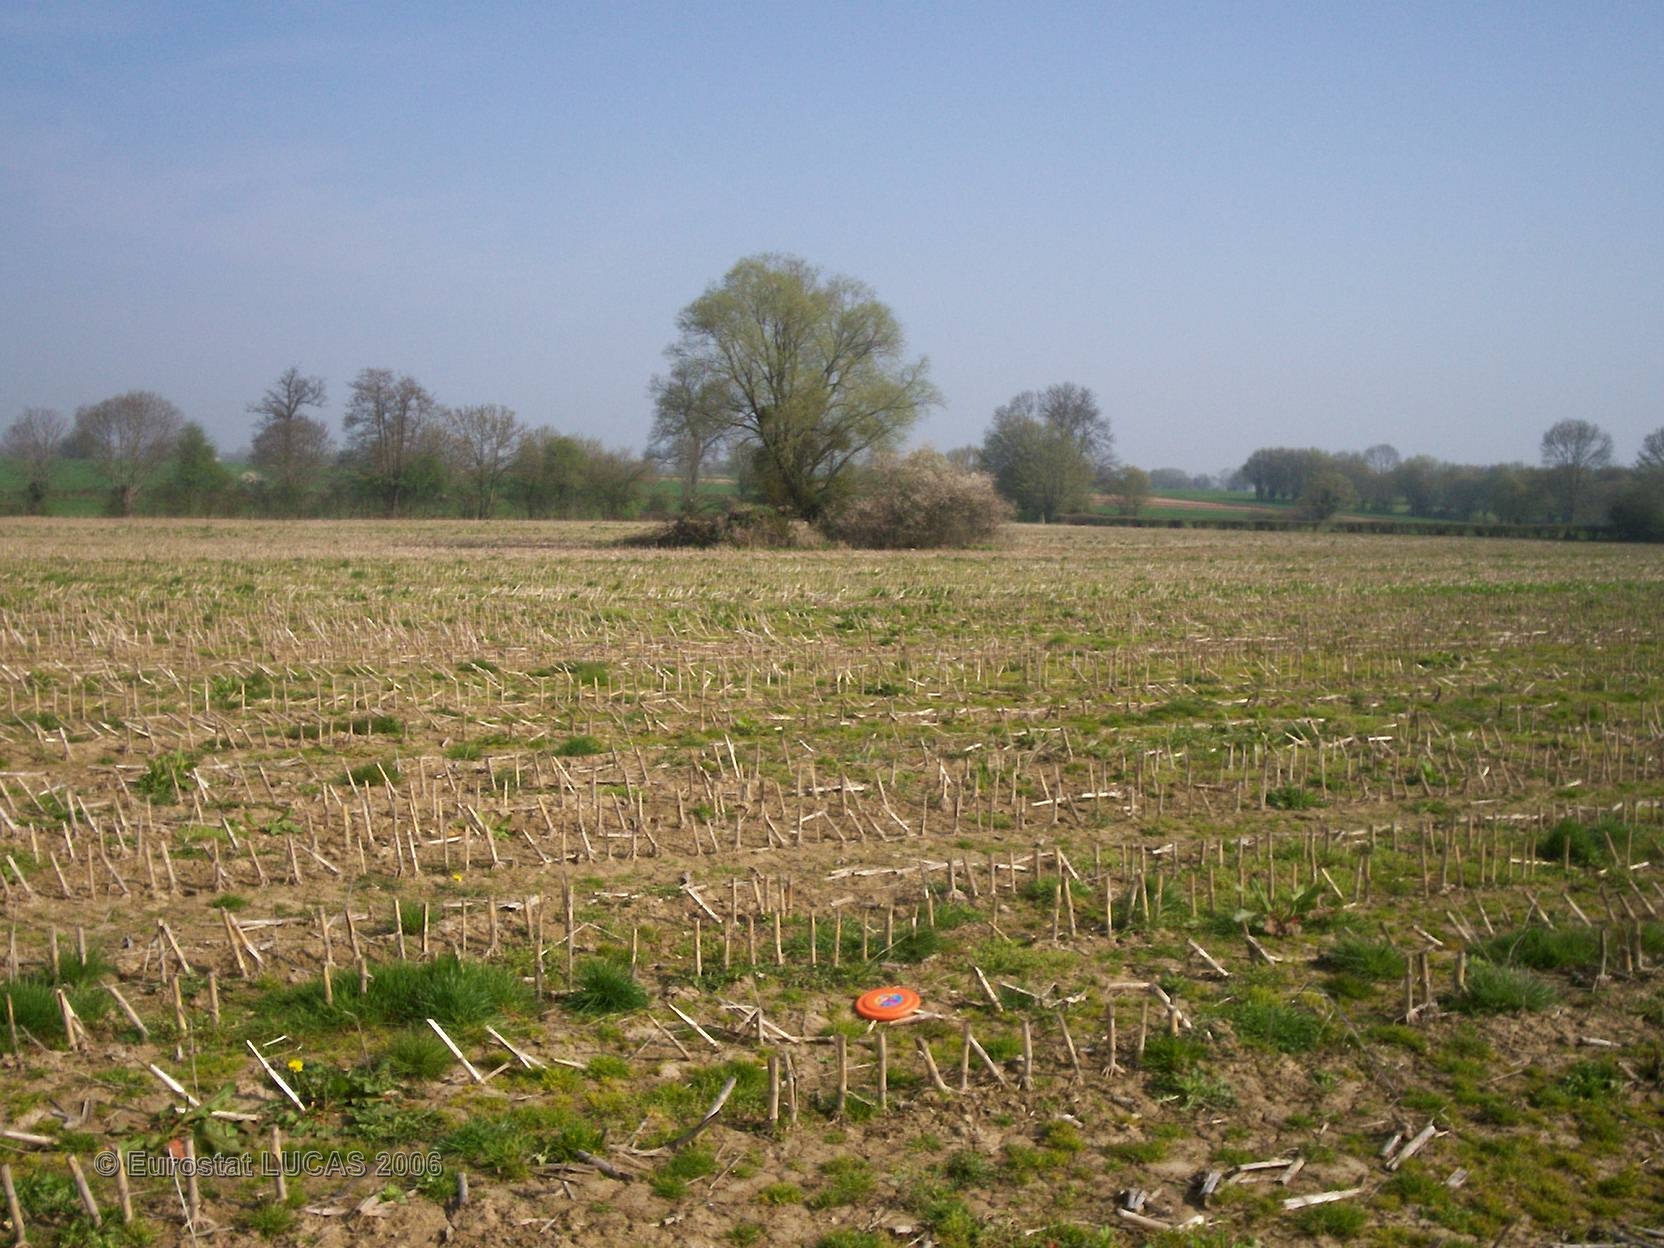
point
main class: Cropland
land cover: Maize
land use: Agriculture (excluding fallow land and kitchen gardens)
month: April
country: FR
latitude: 50.0653
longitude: 3.7208
